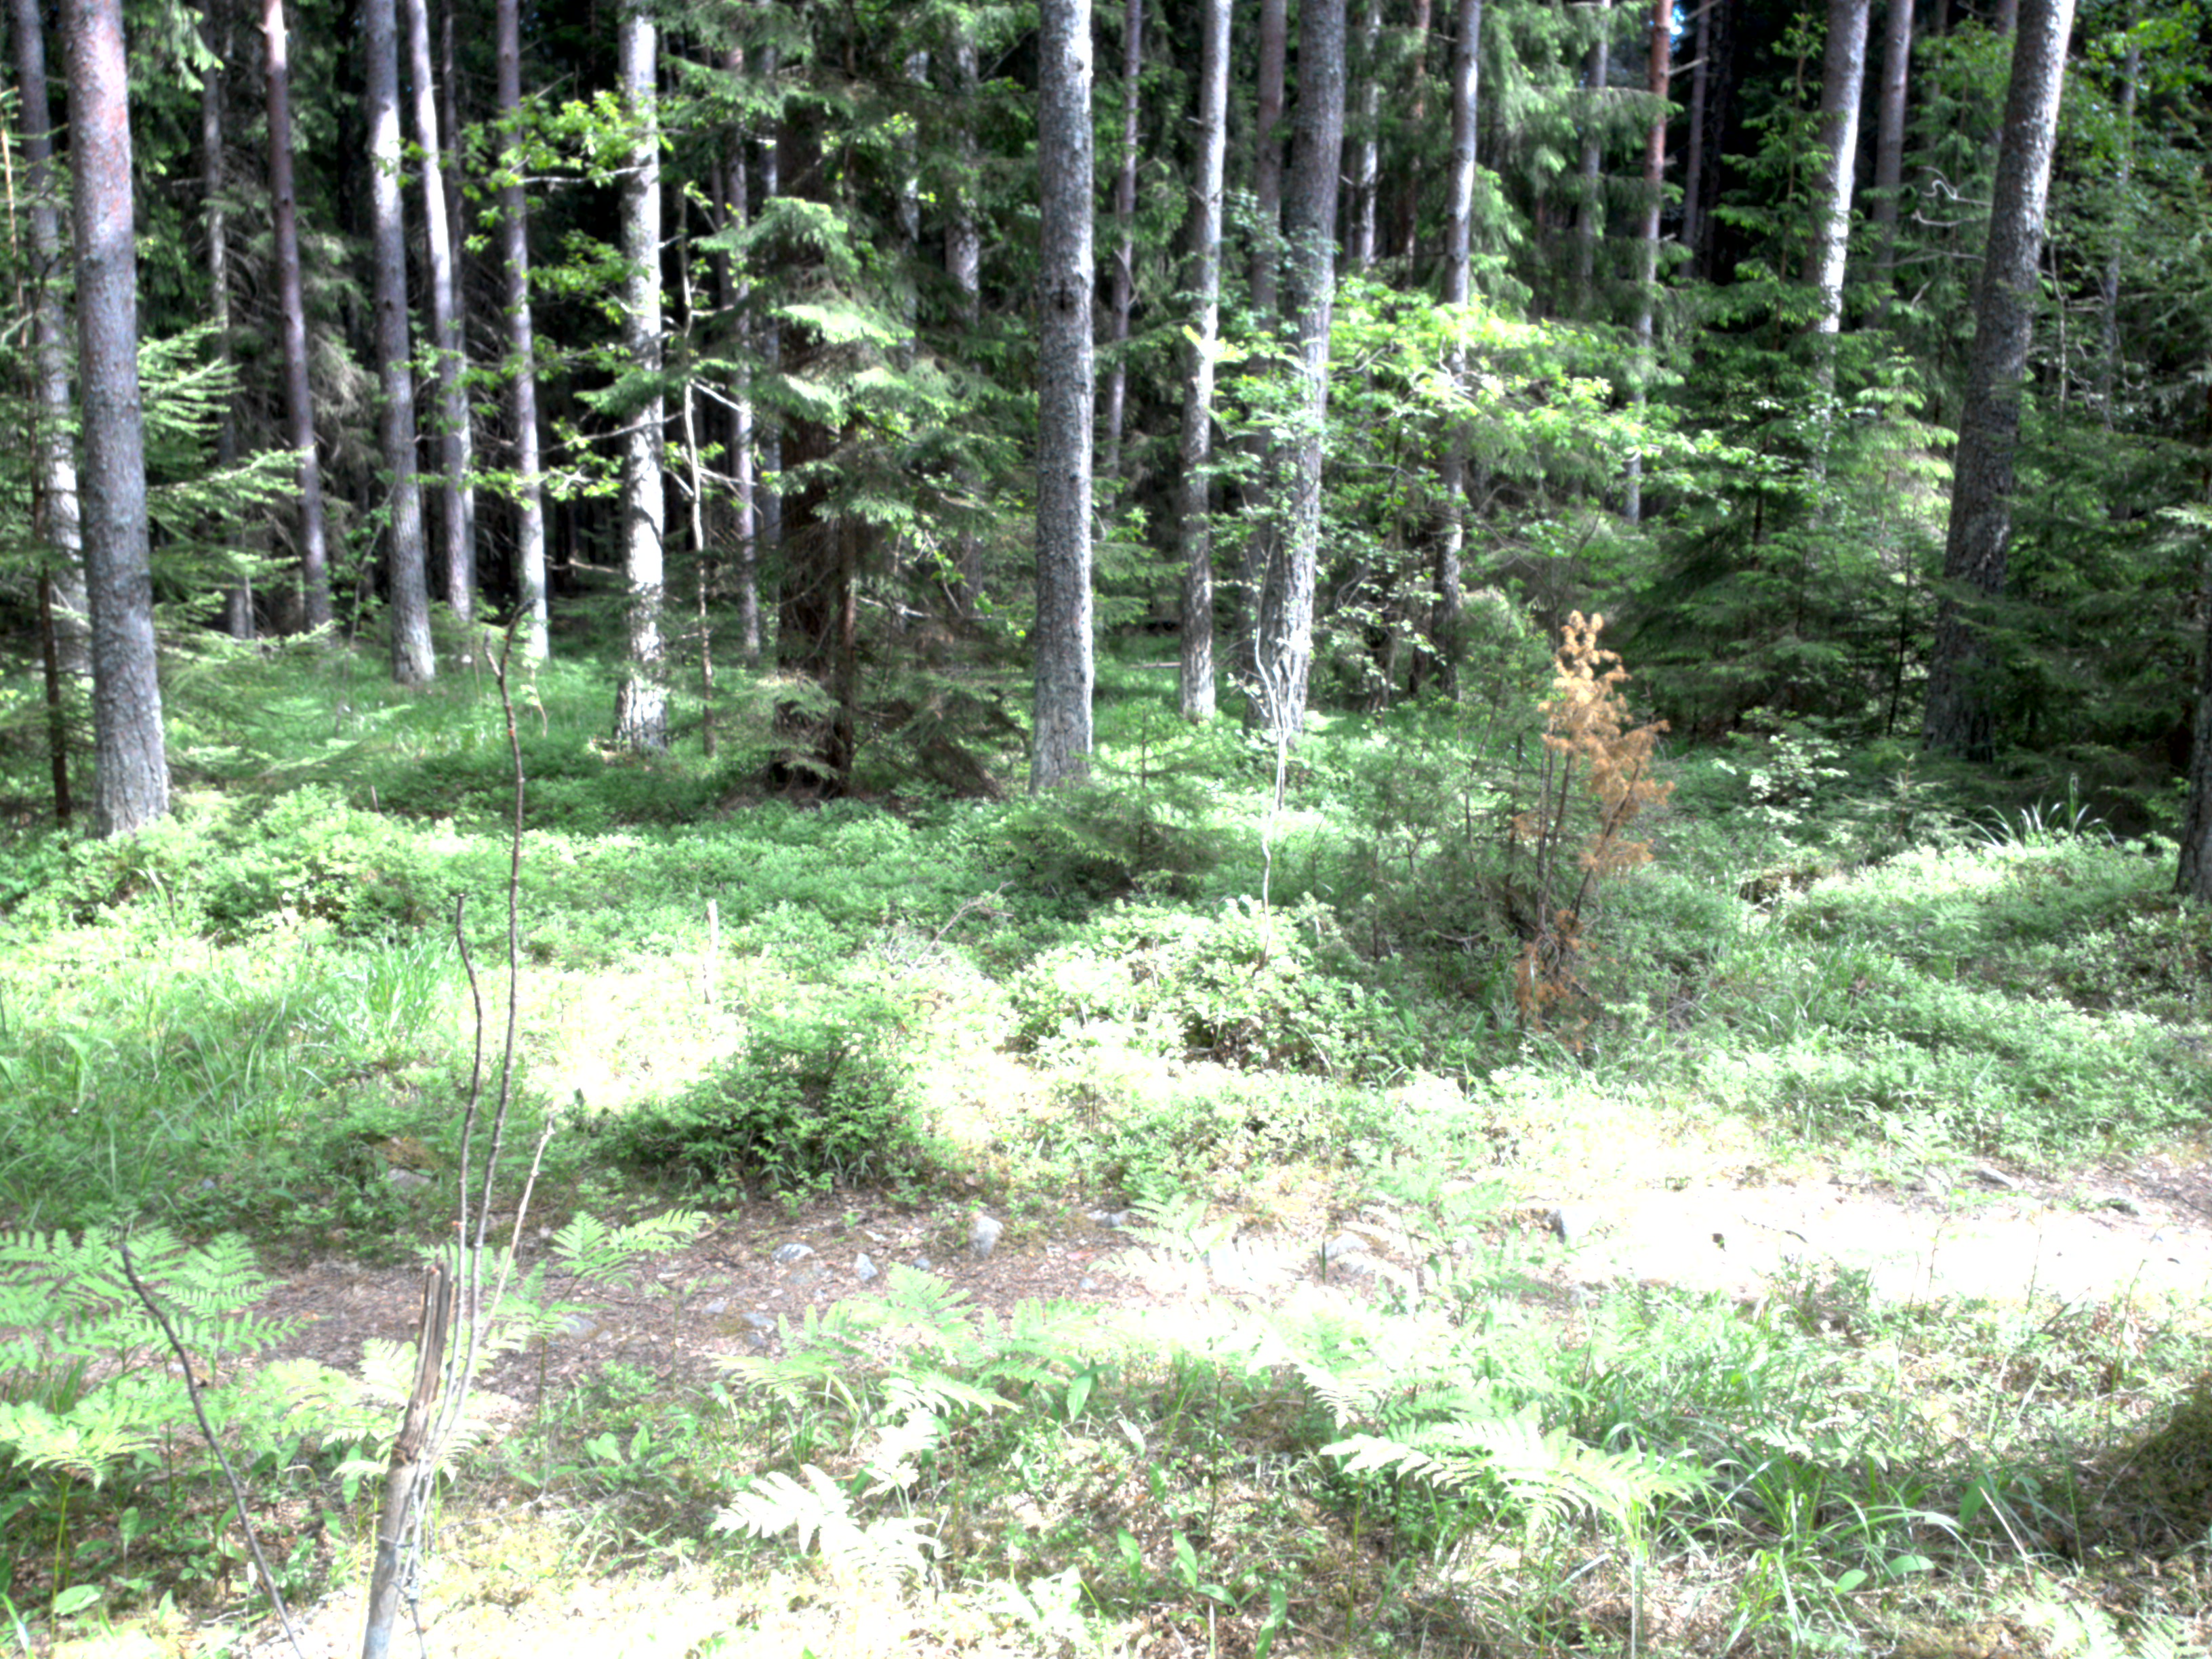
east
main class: Woodland
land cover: Pine dominated coniferous woodland
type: boreal forest
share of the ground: > 75 %
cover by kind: coniferous forest trees 80 %, shrubs 10 %, lichens and mosses 10 %
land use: Forestry
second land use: Sport
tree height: > 5 m
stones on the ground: 10 - 25 %
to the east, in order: Pine dominated coniferous woodland; Tracks; Pine dominated coniferous woodland; Spruce dominated coniferous woodland; Electric lines; Tracks; Spruce dominated coniferous woodland
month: June
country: SE
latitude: 59.4930
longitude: 17.8204
